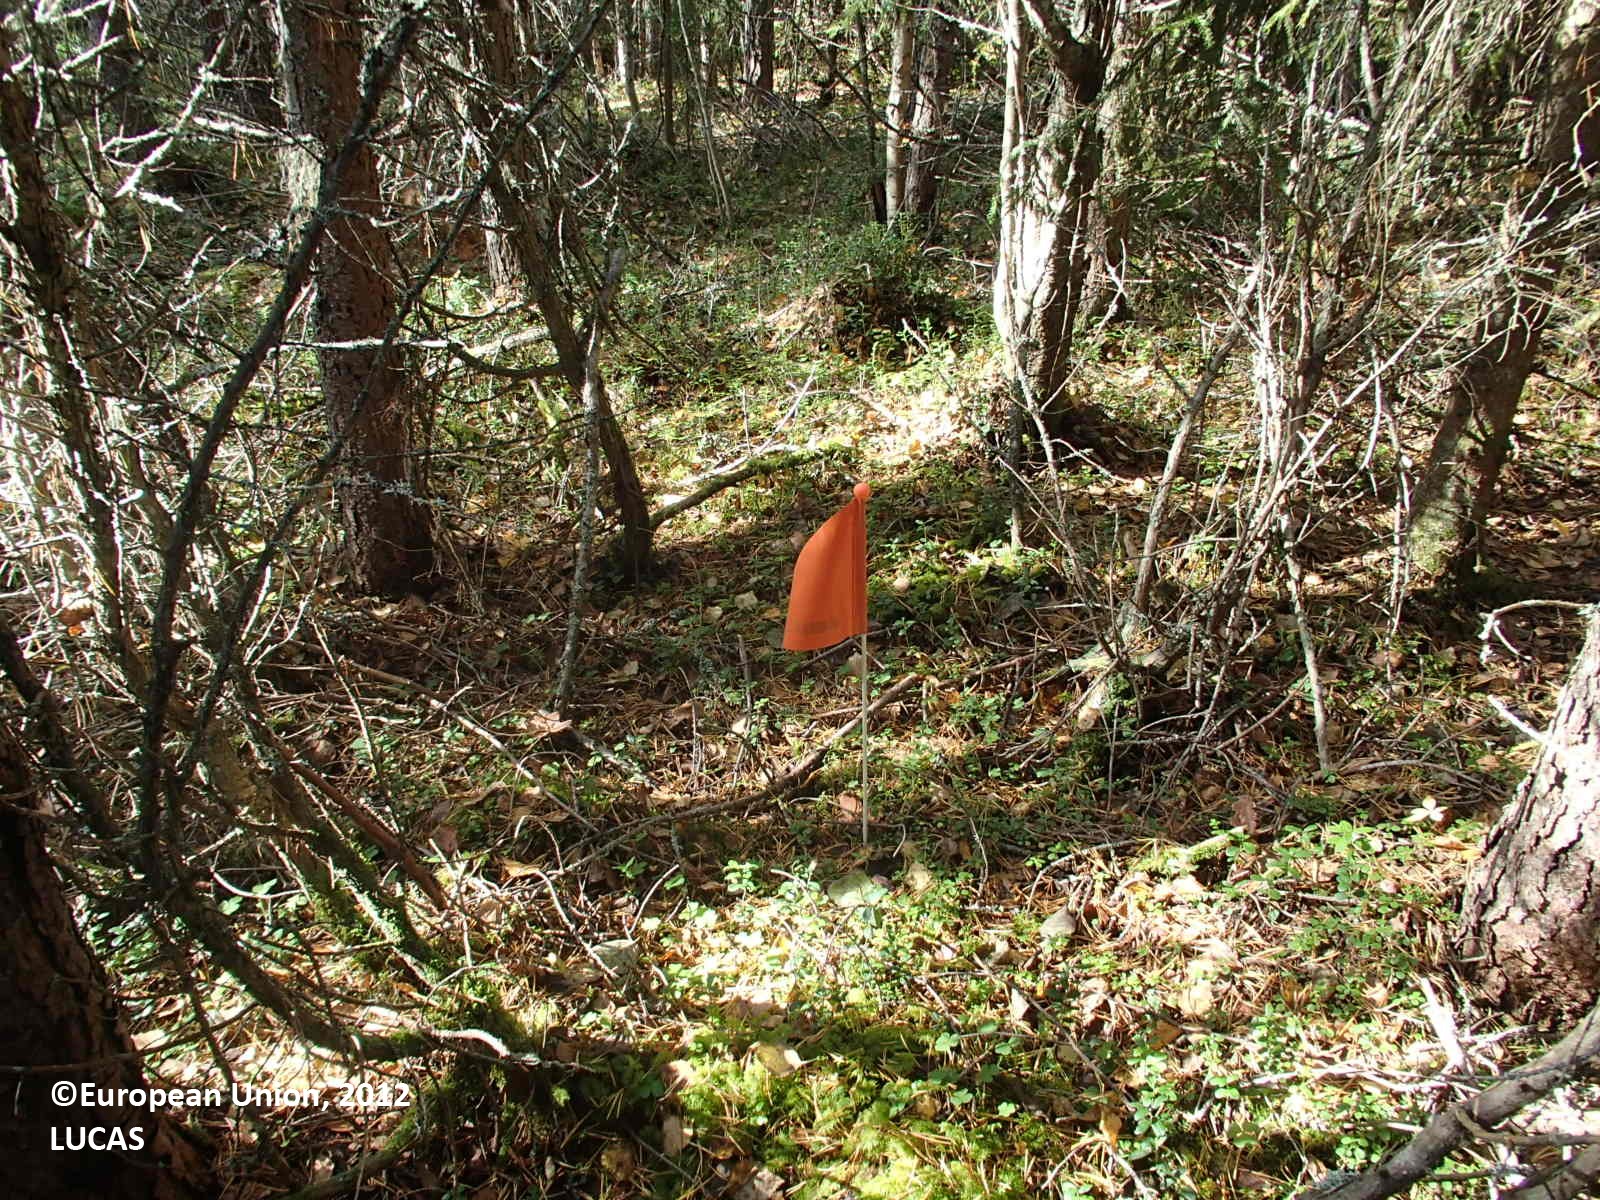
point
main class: Woodland
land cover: Pine dominated mixed woodland
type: boreal forest
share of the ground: > 75 %
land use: Forestry
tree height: > 5 m
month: September
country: FI
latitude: 63.3968
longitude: 27.8005
